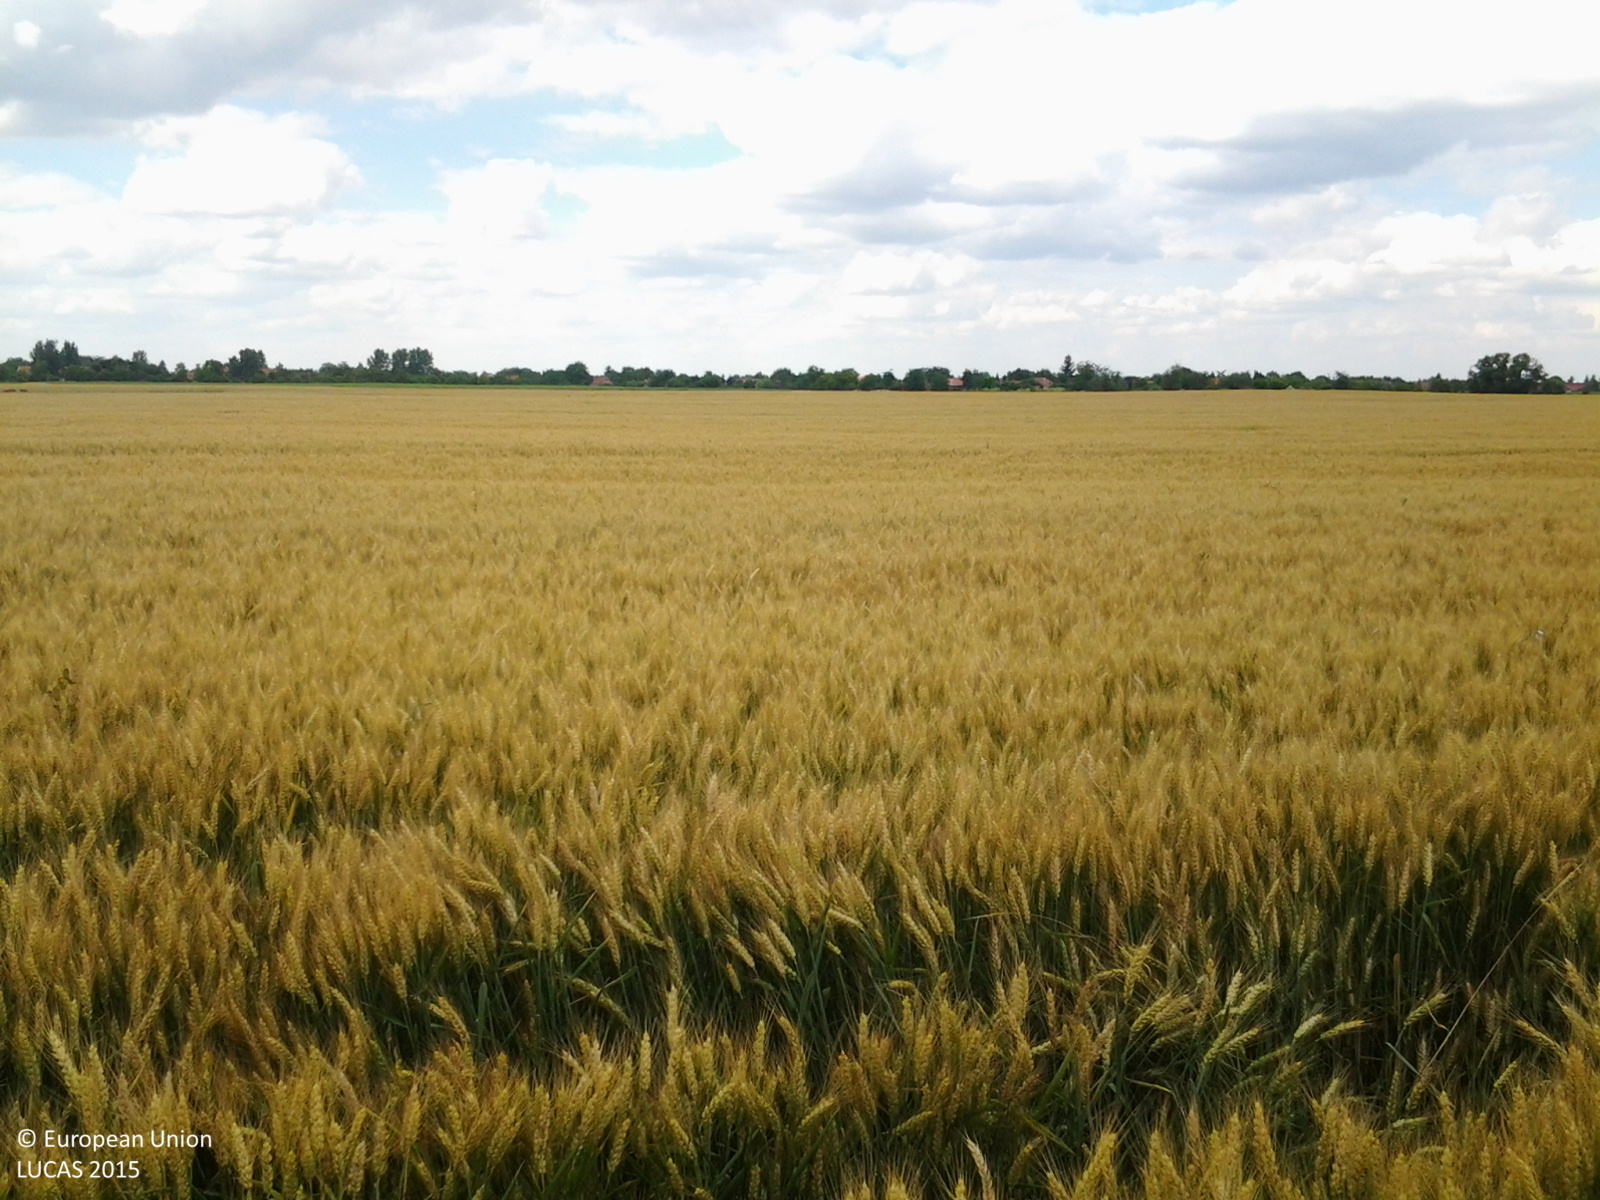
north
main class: Cropland
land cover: Common wheat
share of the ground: > 75 %
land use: Agriculture (excluding fallow land and kitchen gardens)
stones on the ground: < 10 %
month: June
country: HU
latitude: 46.5264
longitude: 21.1803
